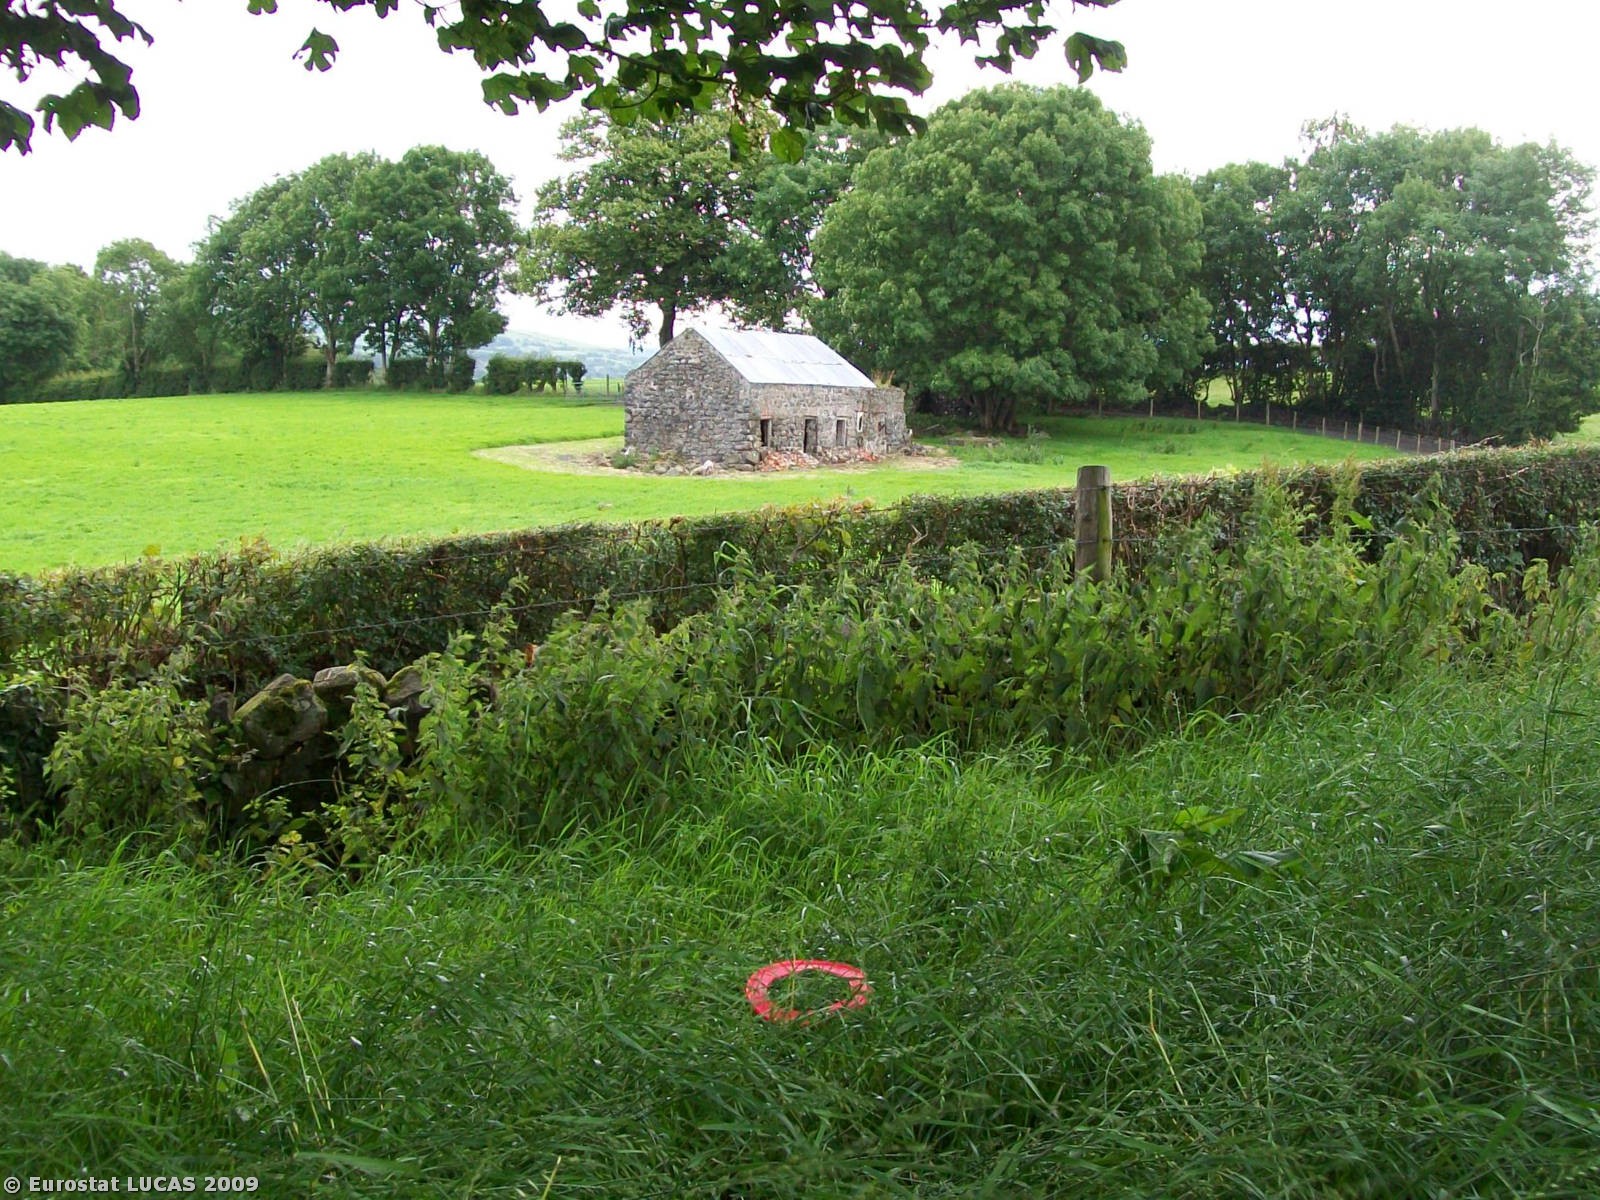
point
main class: Grassland
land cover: Grassland with sparse tree/shrub cover
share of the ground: > 75 %
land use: Agriculture (excluding fallow land and kitchen gardens)
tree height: > 5 m
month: July
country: GB
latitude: 54.8921
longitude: -6.1884
